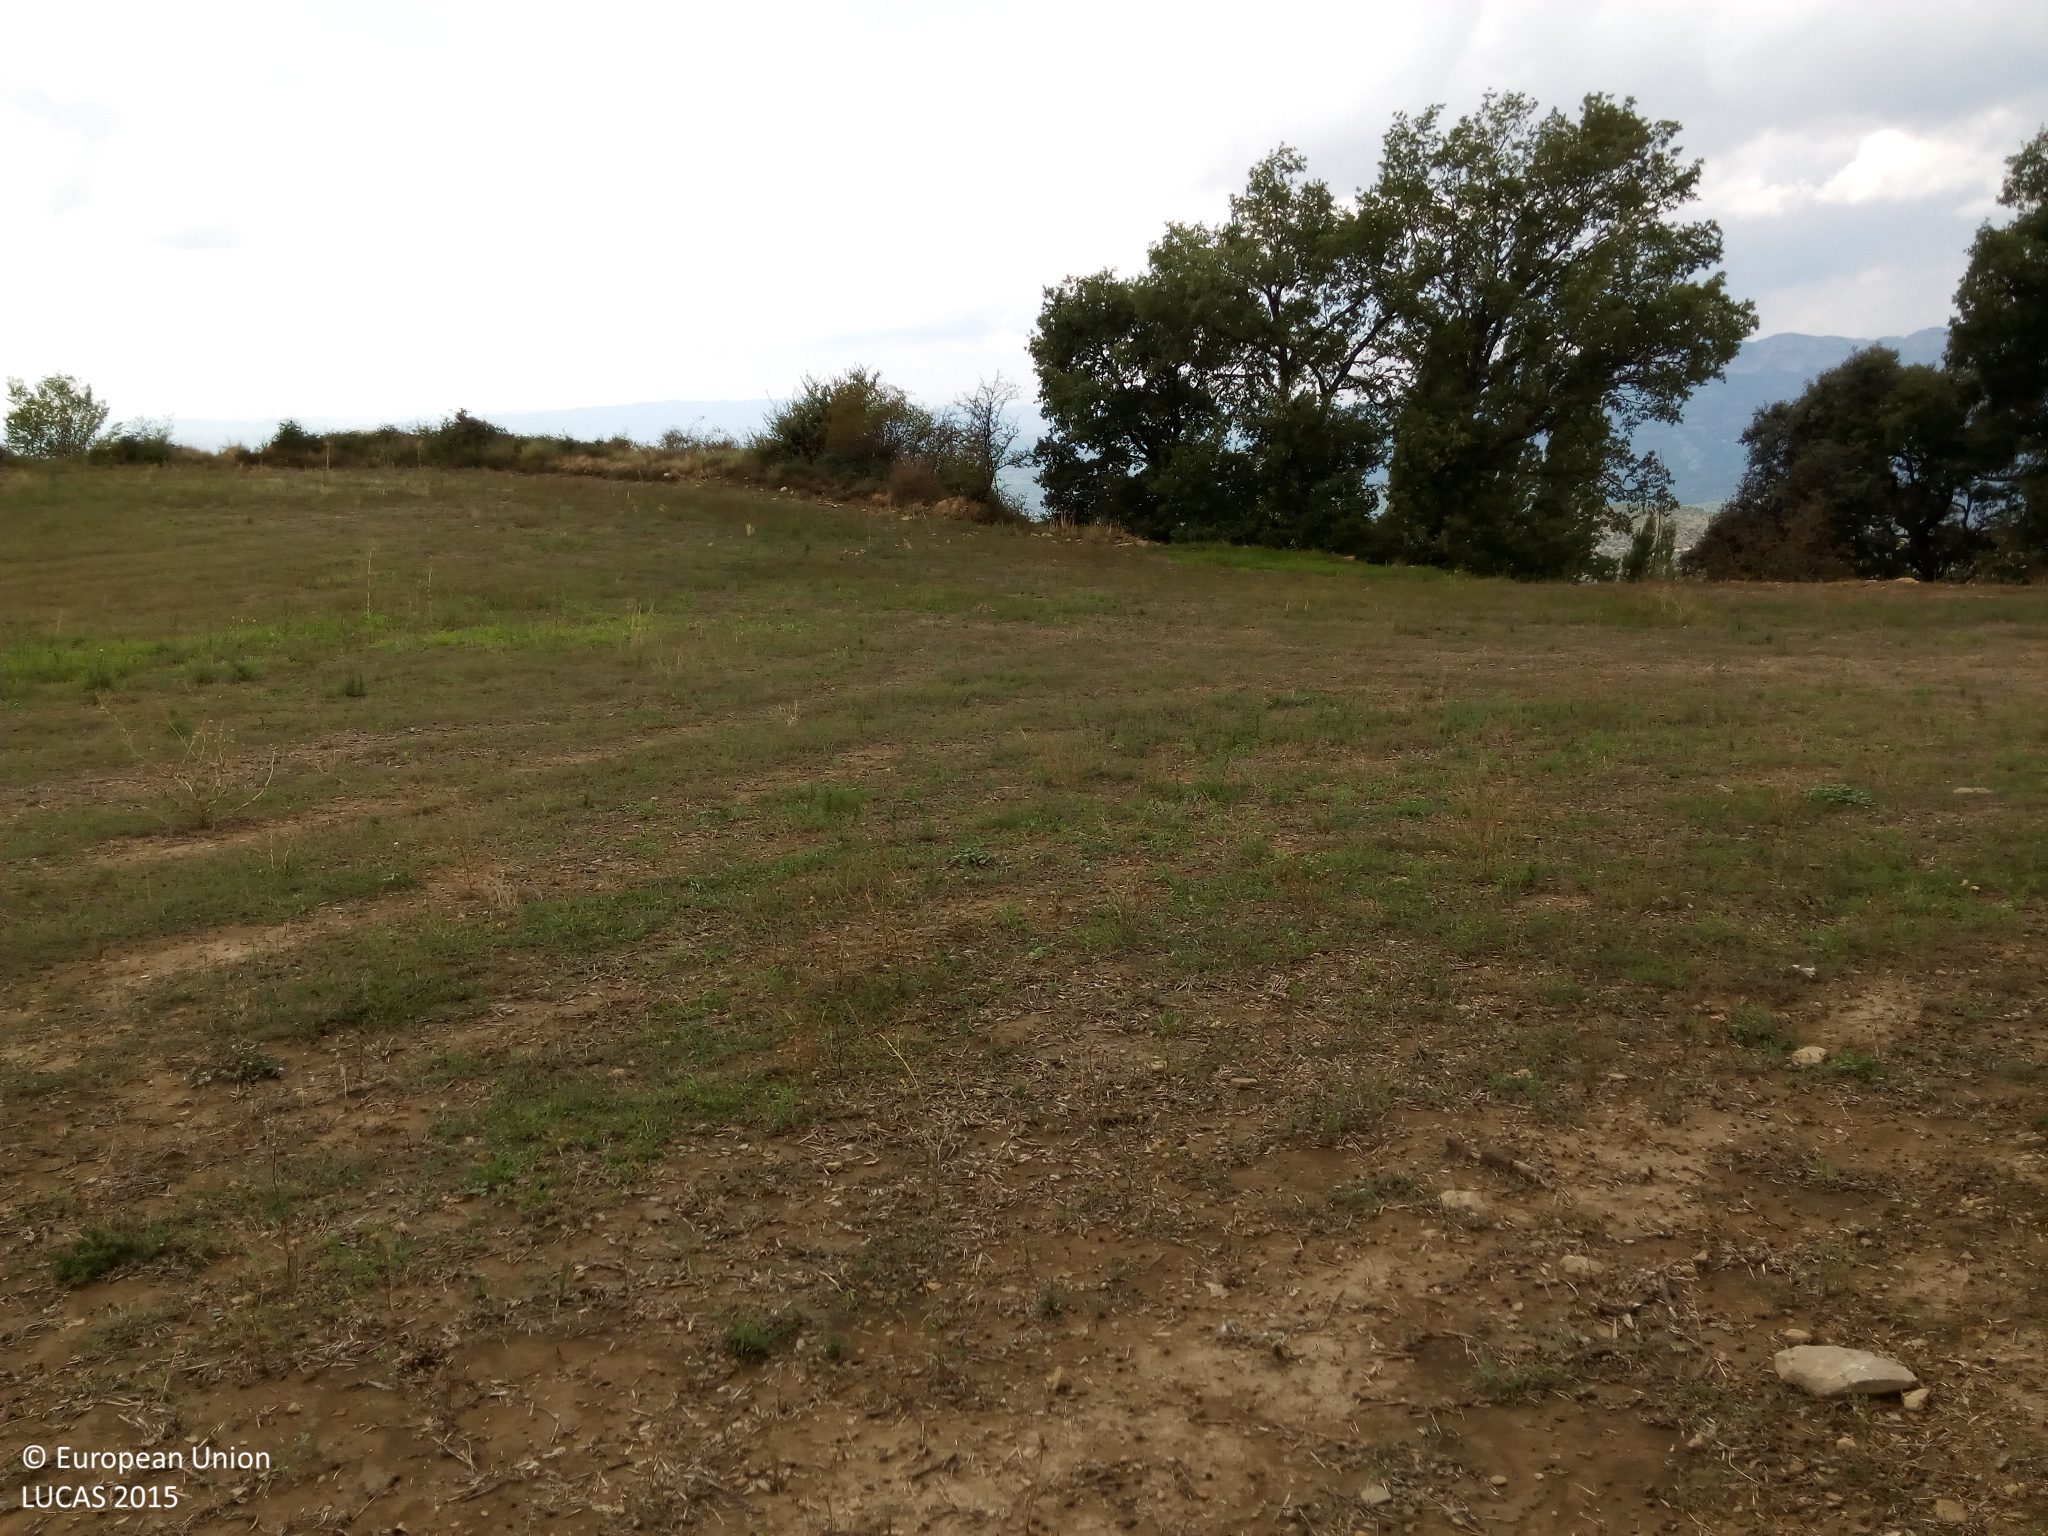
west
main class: Grassland
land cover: Grassland without tree/shrub cover
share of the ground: > 75 %
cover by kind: unconsolidated bare surface 70 %, herbaceous plants 30 %
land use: Agriculture (excluding fallow land and kitchen gardens)
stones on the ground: < 10 %
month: August
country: ES
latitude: 42.2491
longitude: 0.5652
